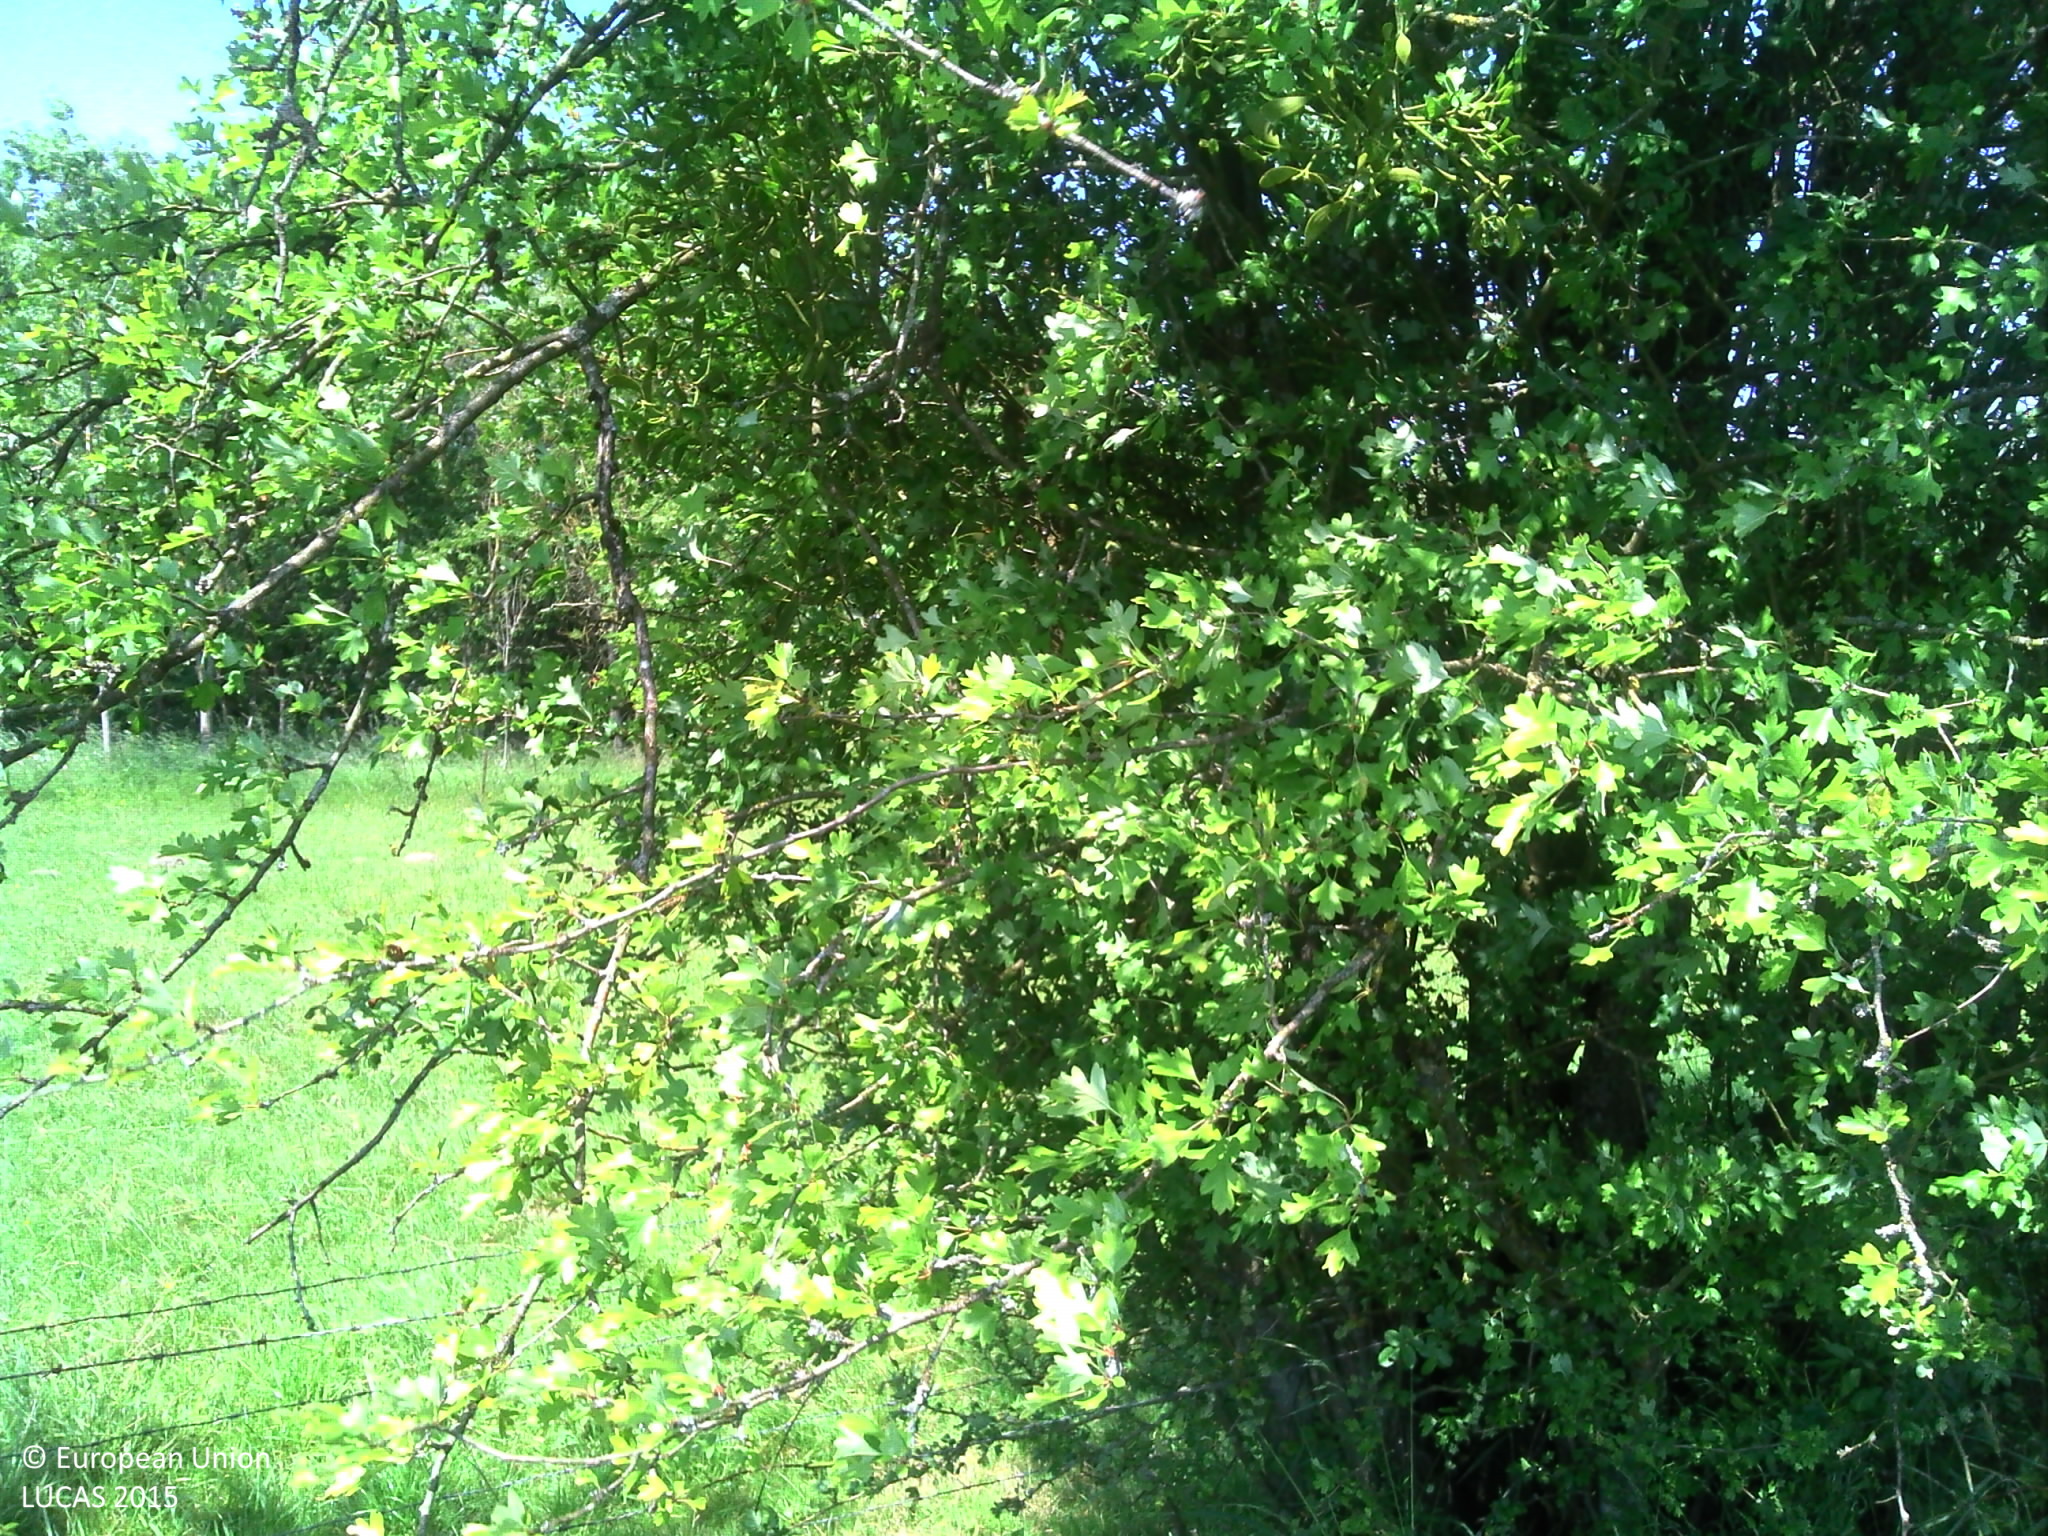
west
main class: Grassland
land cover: Grassland without tree/shrub cover
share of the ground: > 75 %
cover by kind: herbaceous plants 100 %
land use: Agriculture (excluding fallow land and kitchen gardens)
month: June
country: FR
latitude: 49.8159
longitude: 4.1161
